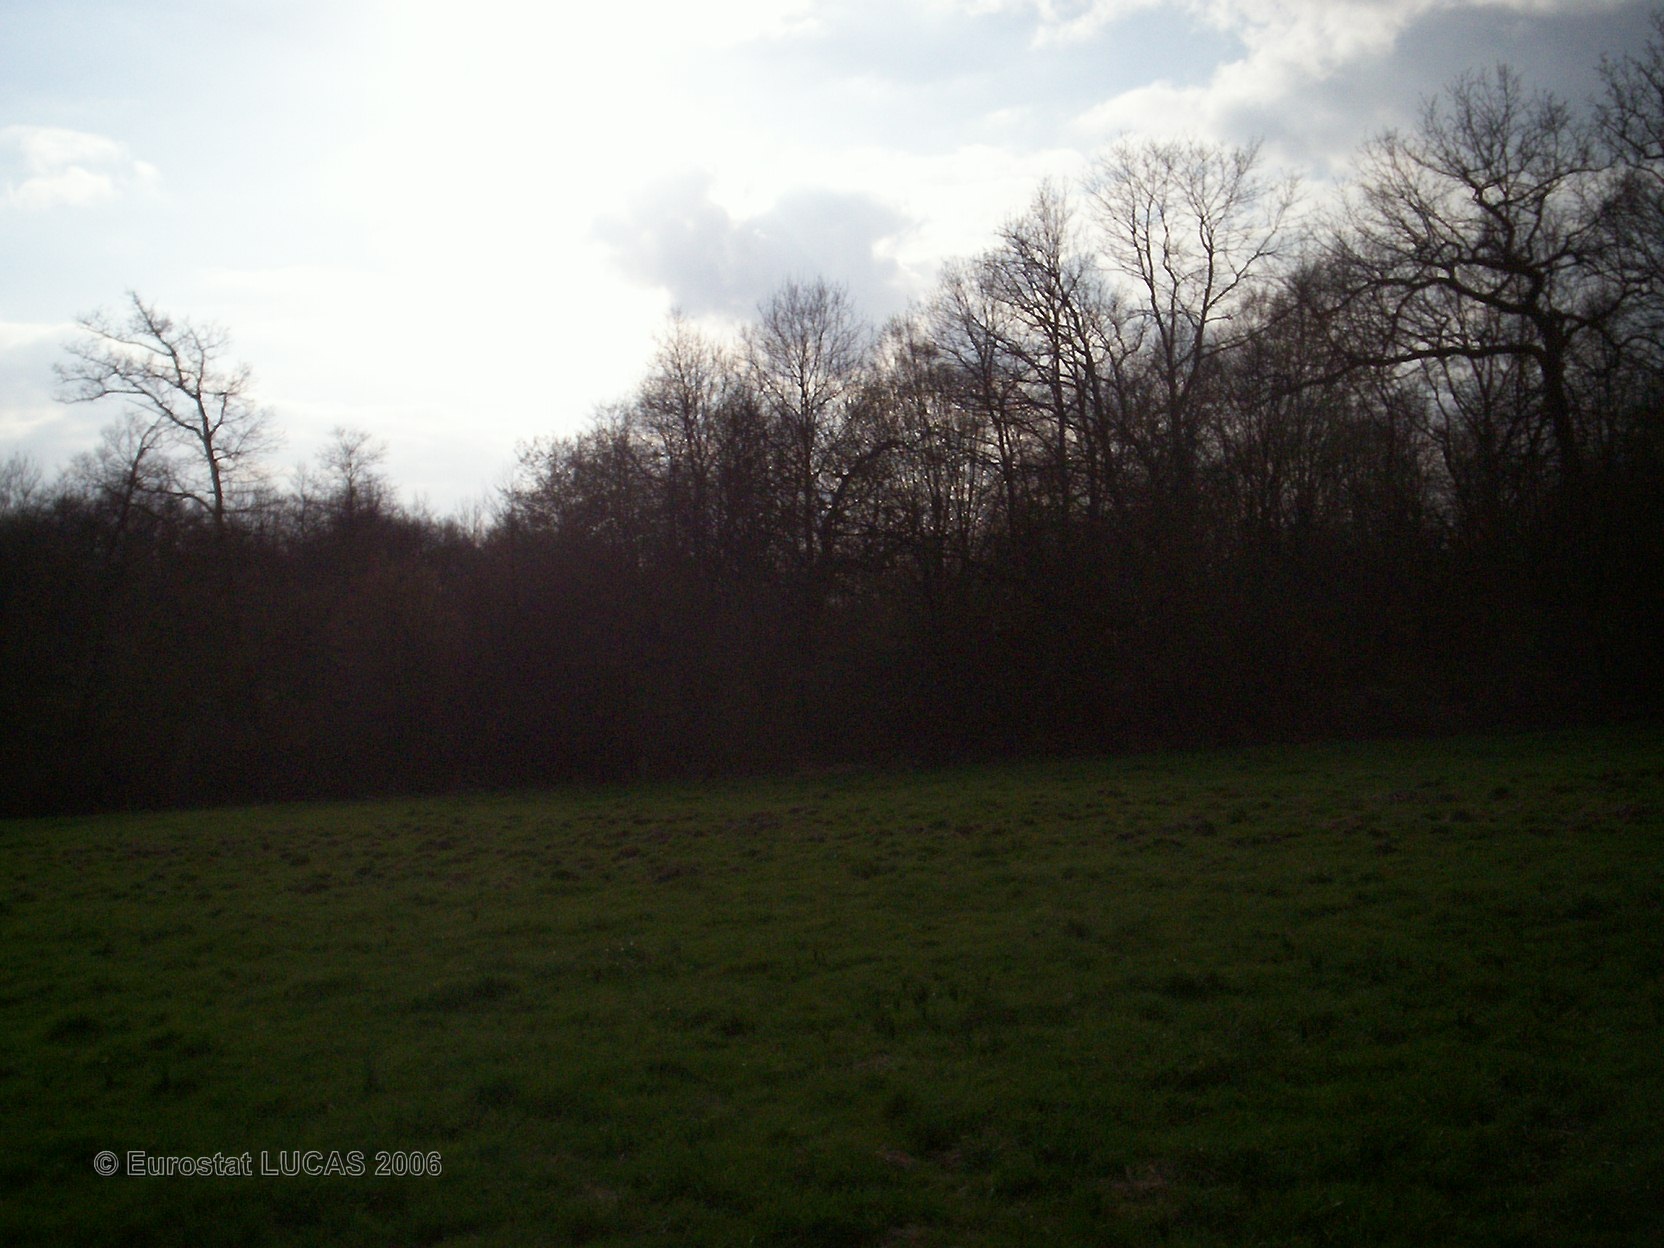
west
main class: Grassland
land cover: Grassland without tree/shrub cover
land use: Agriculture (excluding fallow land and kitchen gardens)
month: April
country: FR
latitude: 49.5177
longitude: 5.0387
